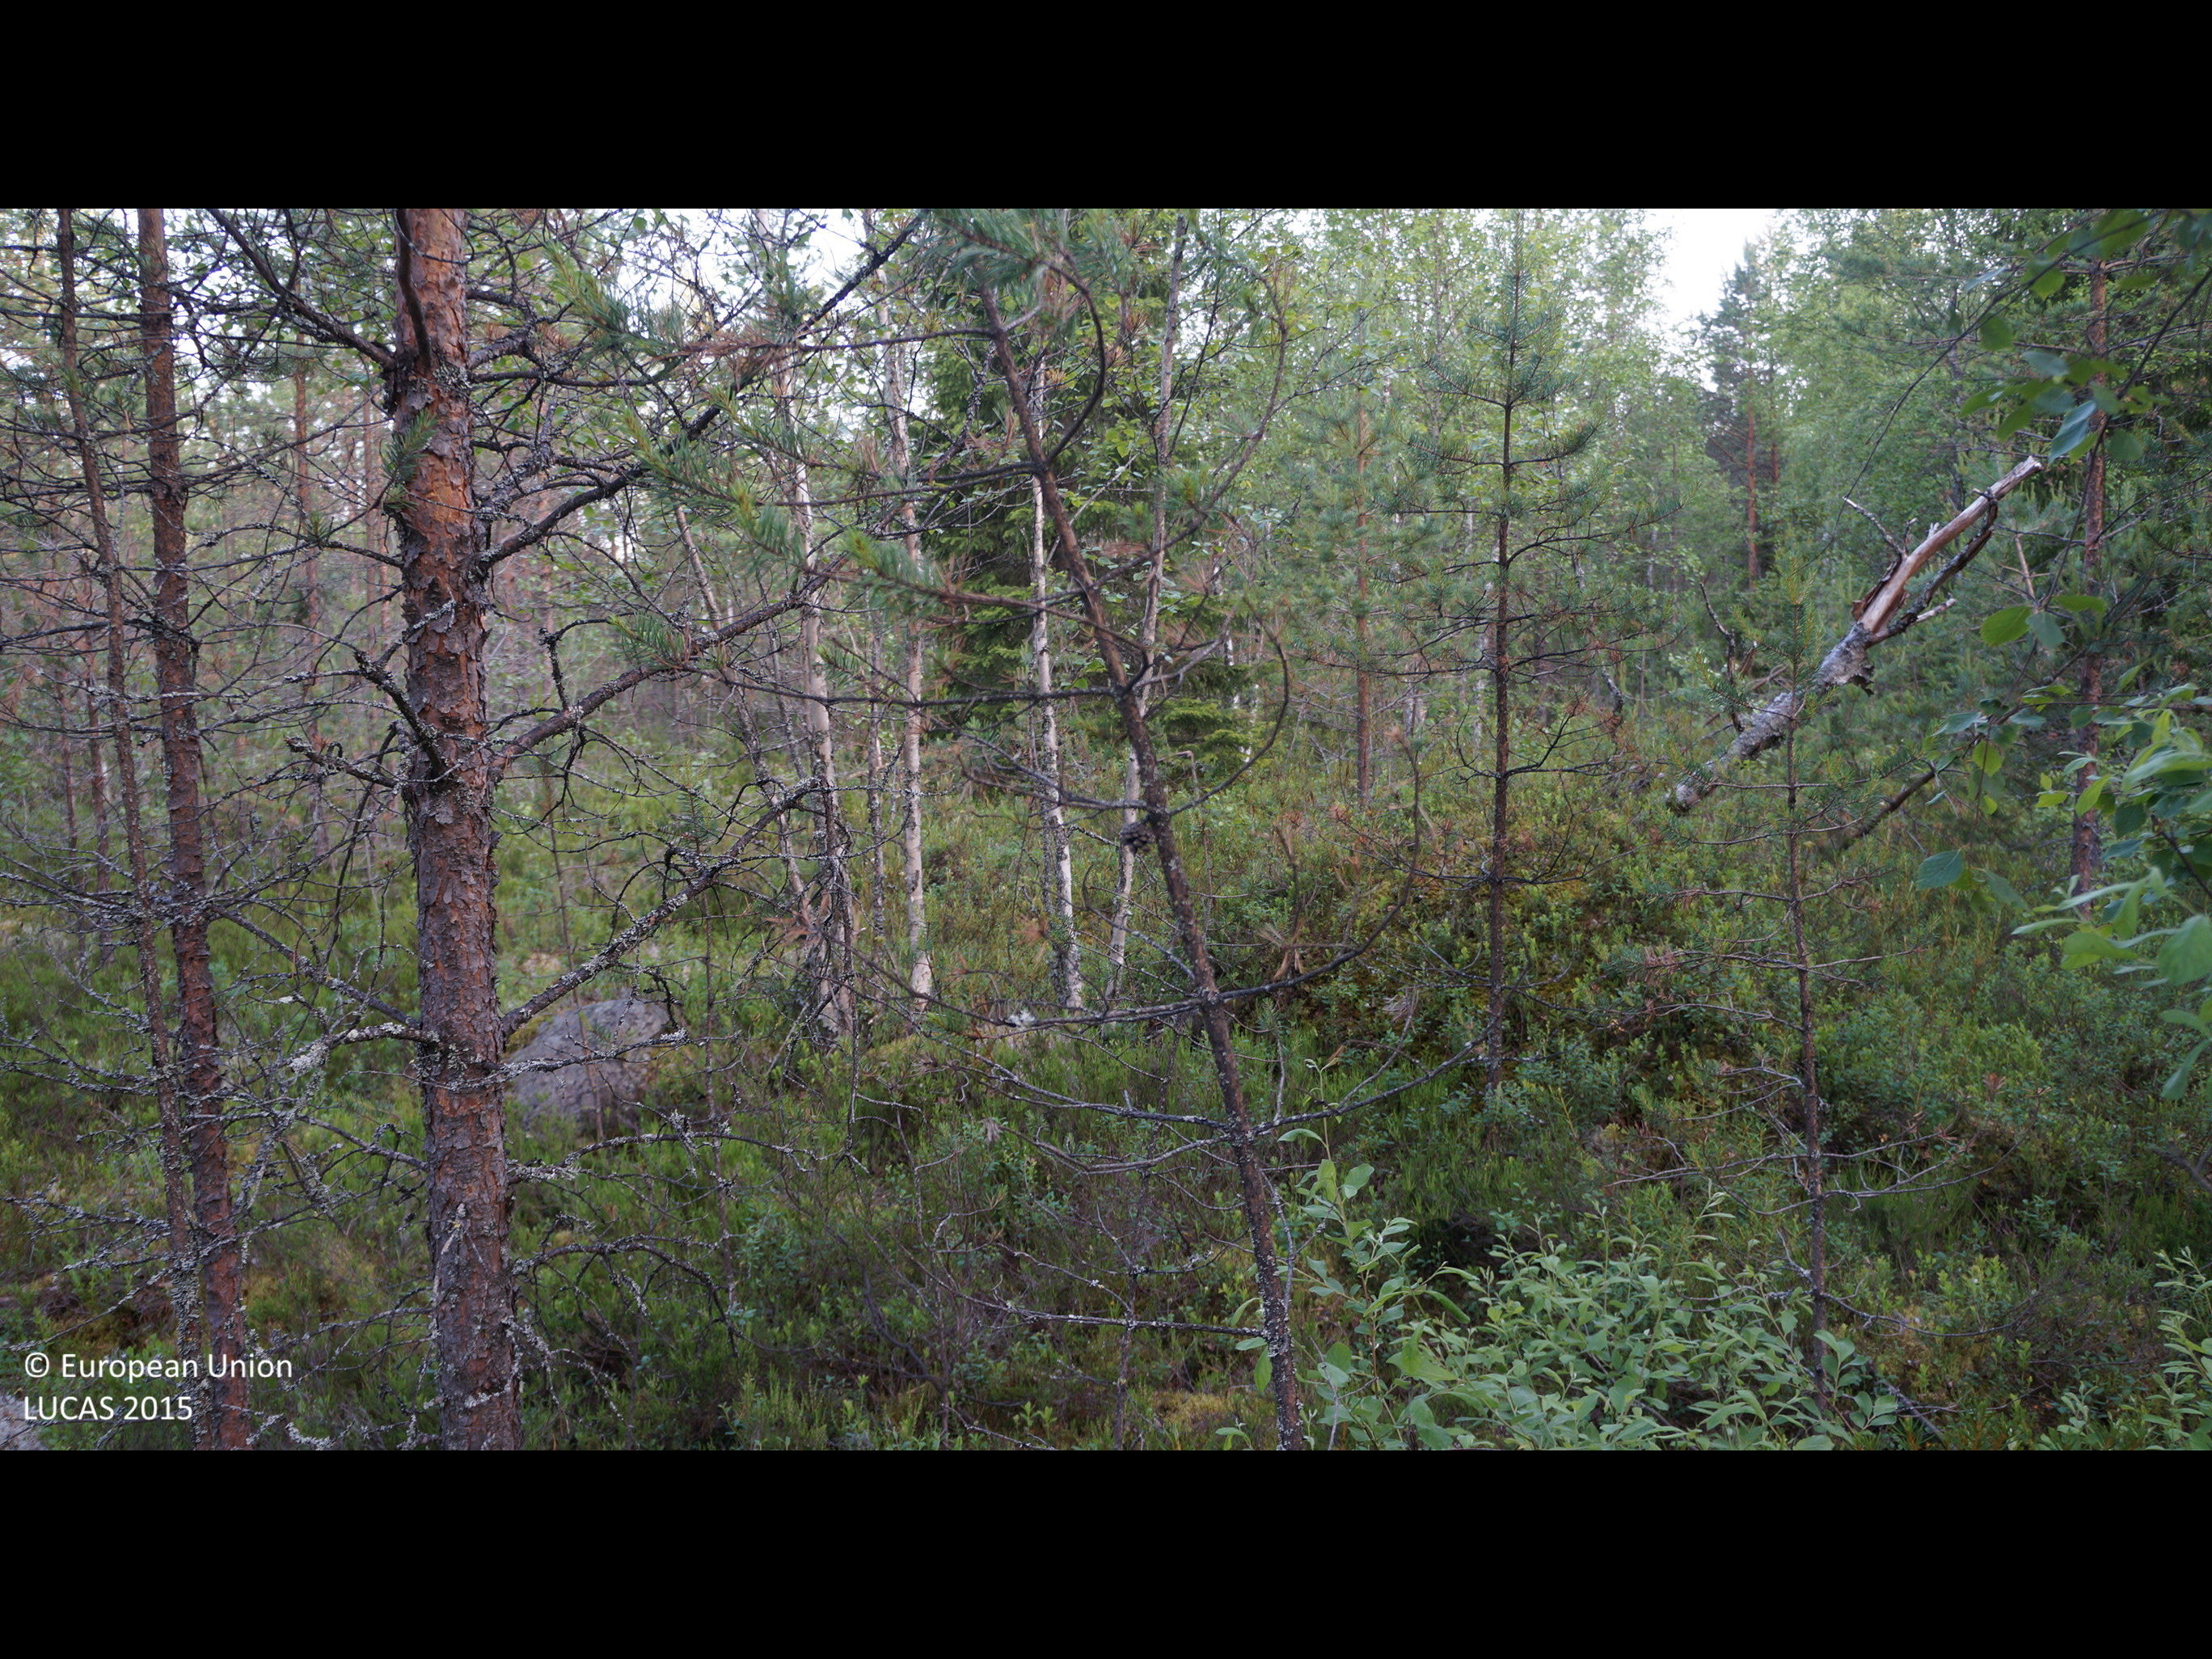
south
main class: Woodland
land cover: Pine dominated mixed woodland
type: boreal forest
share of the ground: 50 - 75 %
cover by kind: shrubs 40 %, coniferous forest trees 35 %, broadleaved forest trees 15 %, lichens and mosses 10 %
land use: Forestry
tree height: > 5 m
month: July
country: FI
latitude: 63.7734
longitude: 24.0014
